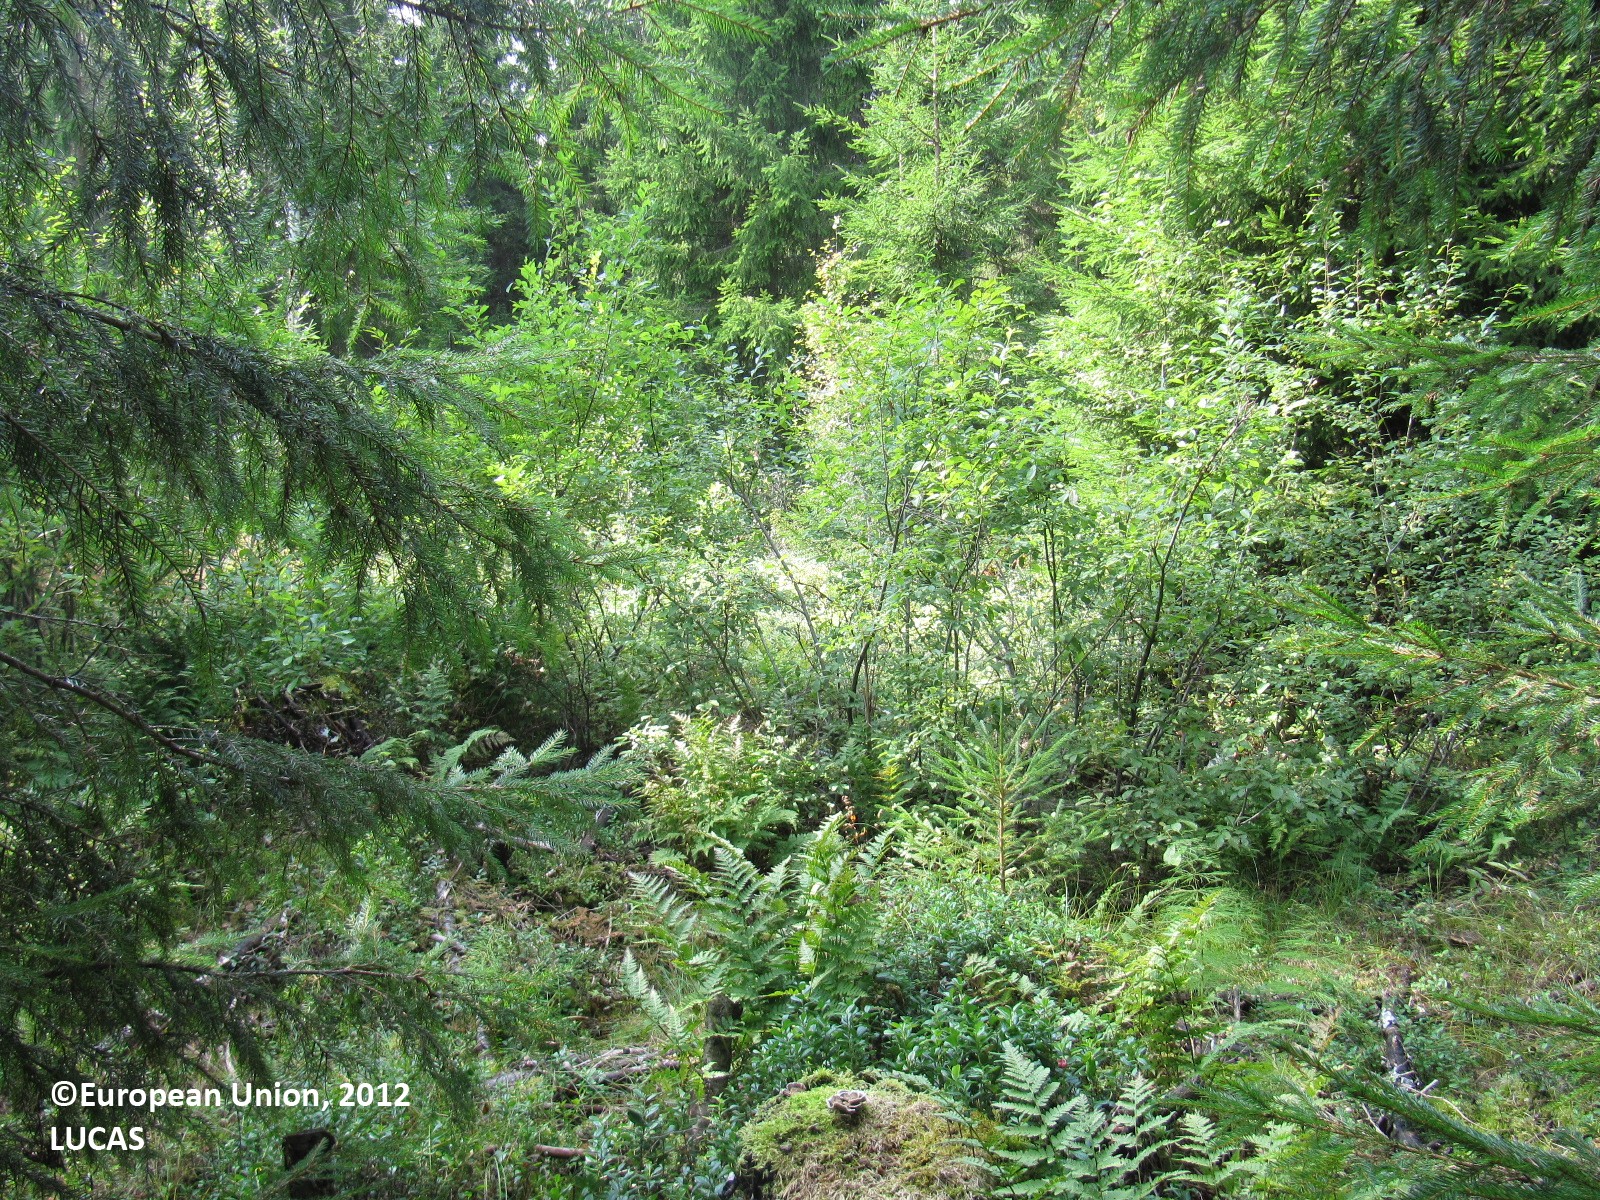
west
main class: Woodland
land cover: Spruce dominated coniferous woodland
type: boreal forest
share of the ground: > 75 %
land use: Forestry
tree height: > 5 m
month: August
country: FI
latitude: 61.1709
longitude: 22.9561
